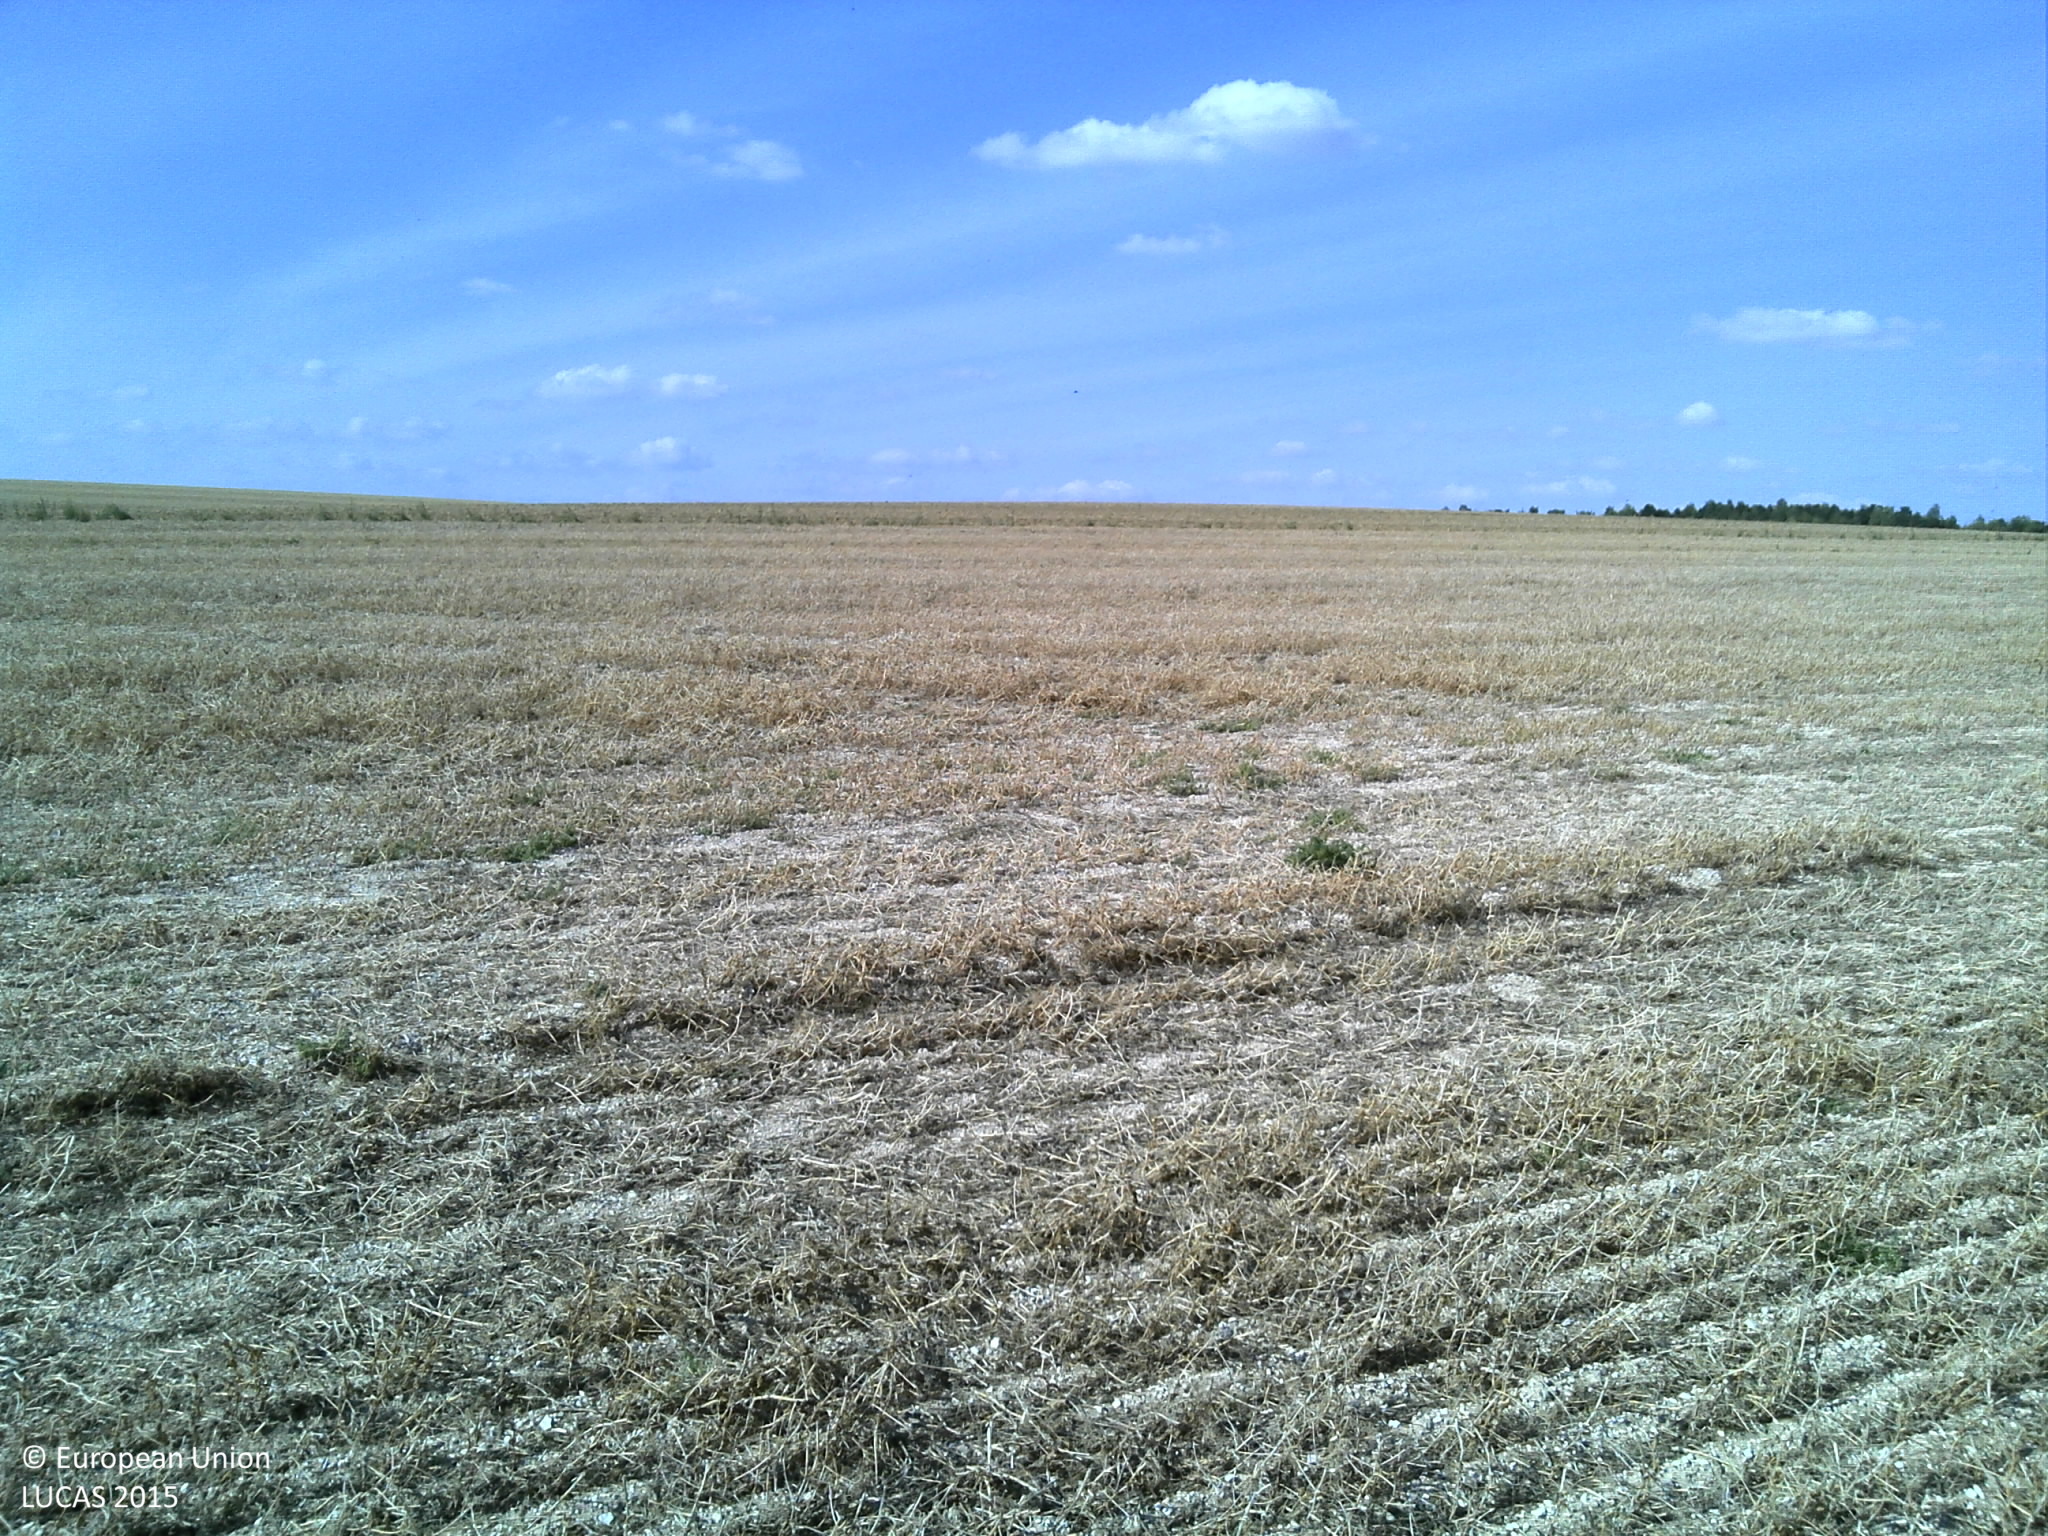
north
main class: Cropland
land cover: Dry pulses
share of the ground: > 75 %
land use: Agriculture (excluding fallow land and kitchen gardens)
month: August
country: FR
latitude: 48.9402
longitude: 4.6316
